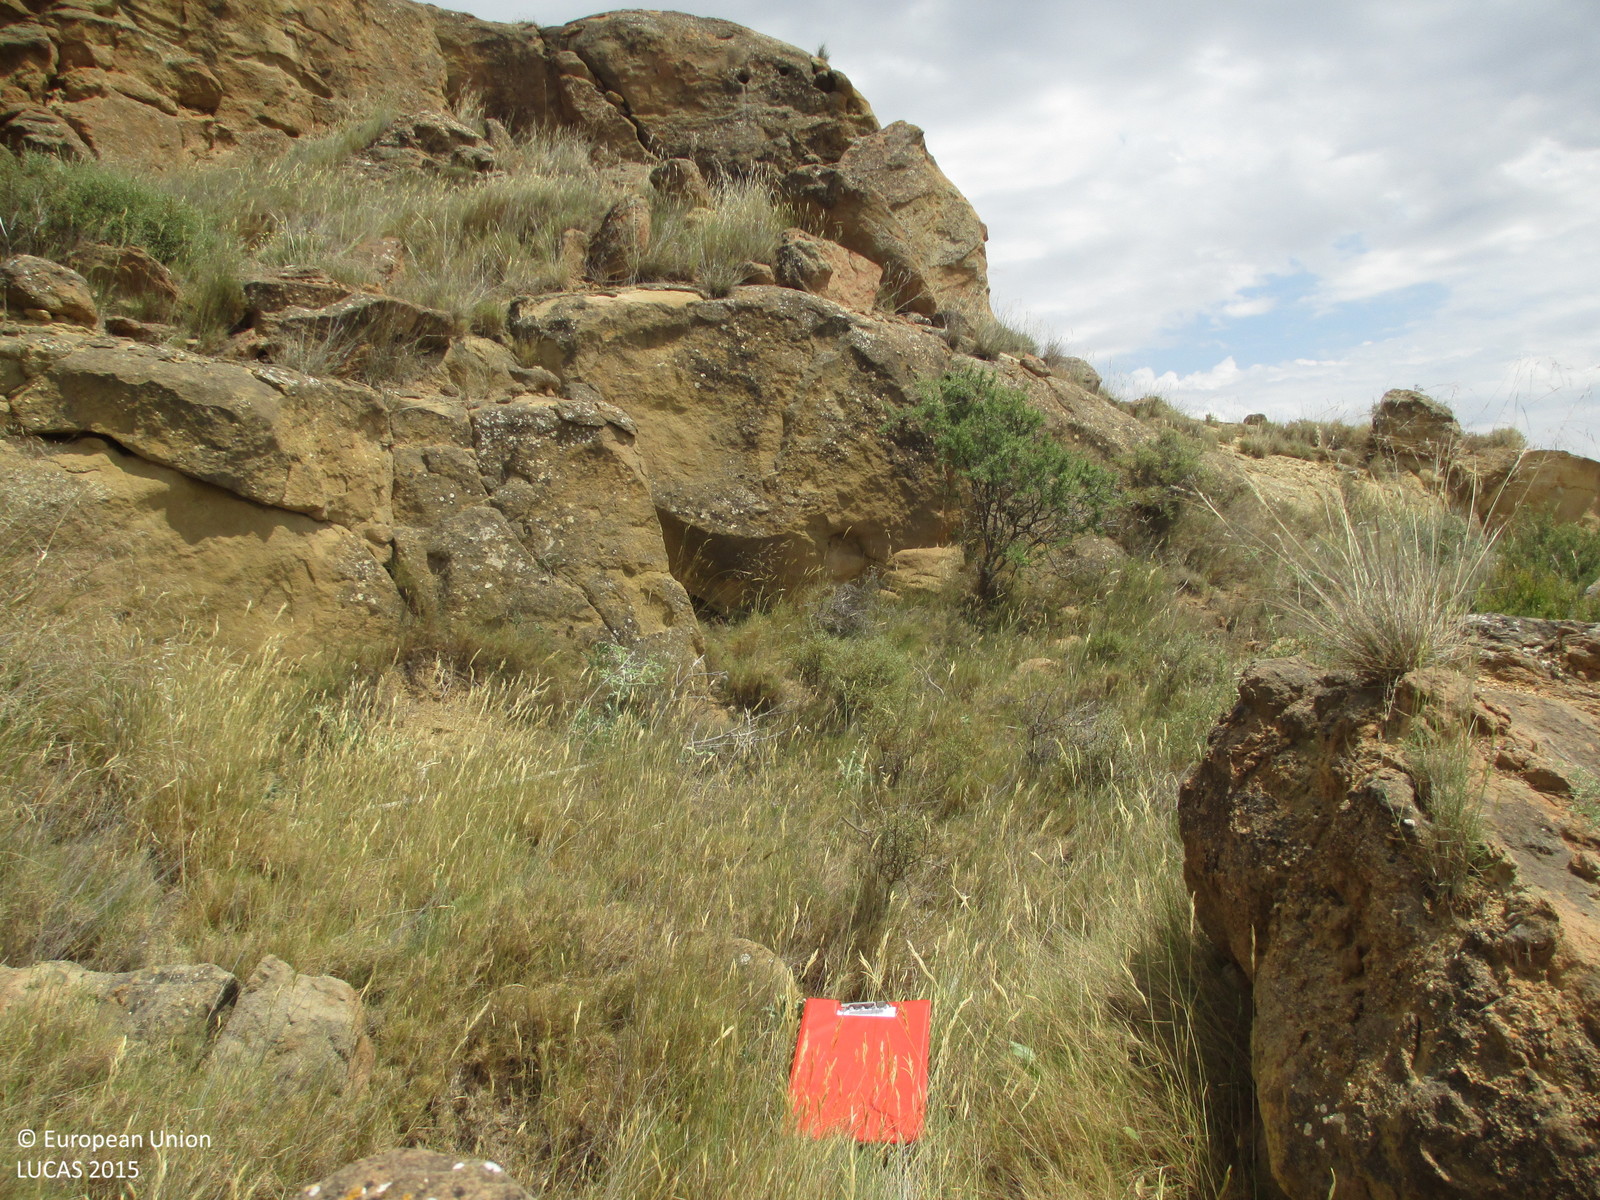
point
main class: Shrubland
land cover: Shrubland without tree cover
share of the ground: > 75 %
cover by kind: shrubs 90 %, herbaceous plants 10 %
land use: Semi-natural and natural areas not in use
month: May
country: ES
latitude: 41.9341
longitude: -0.2348
